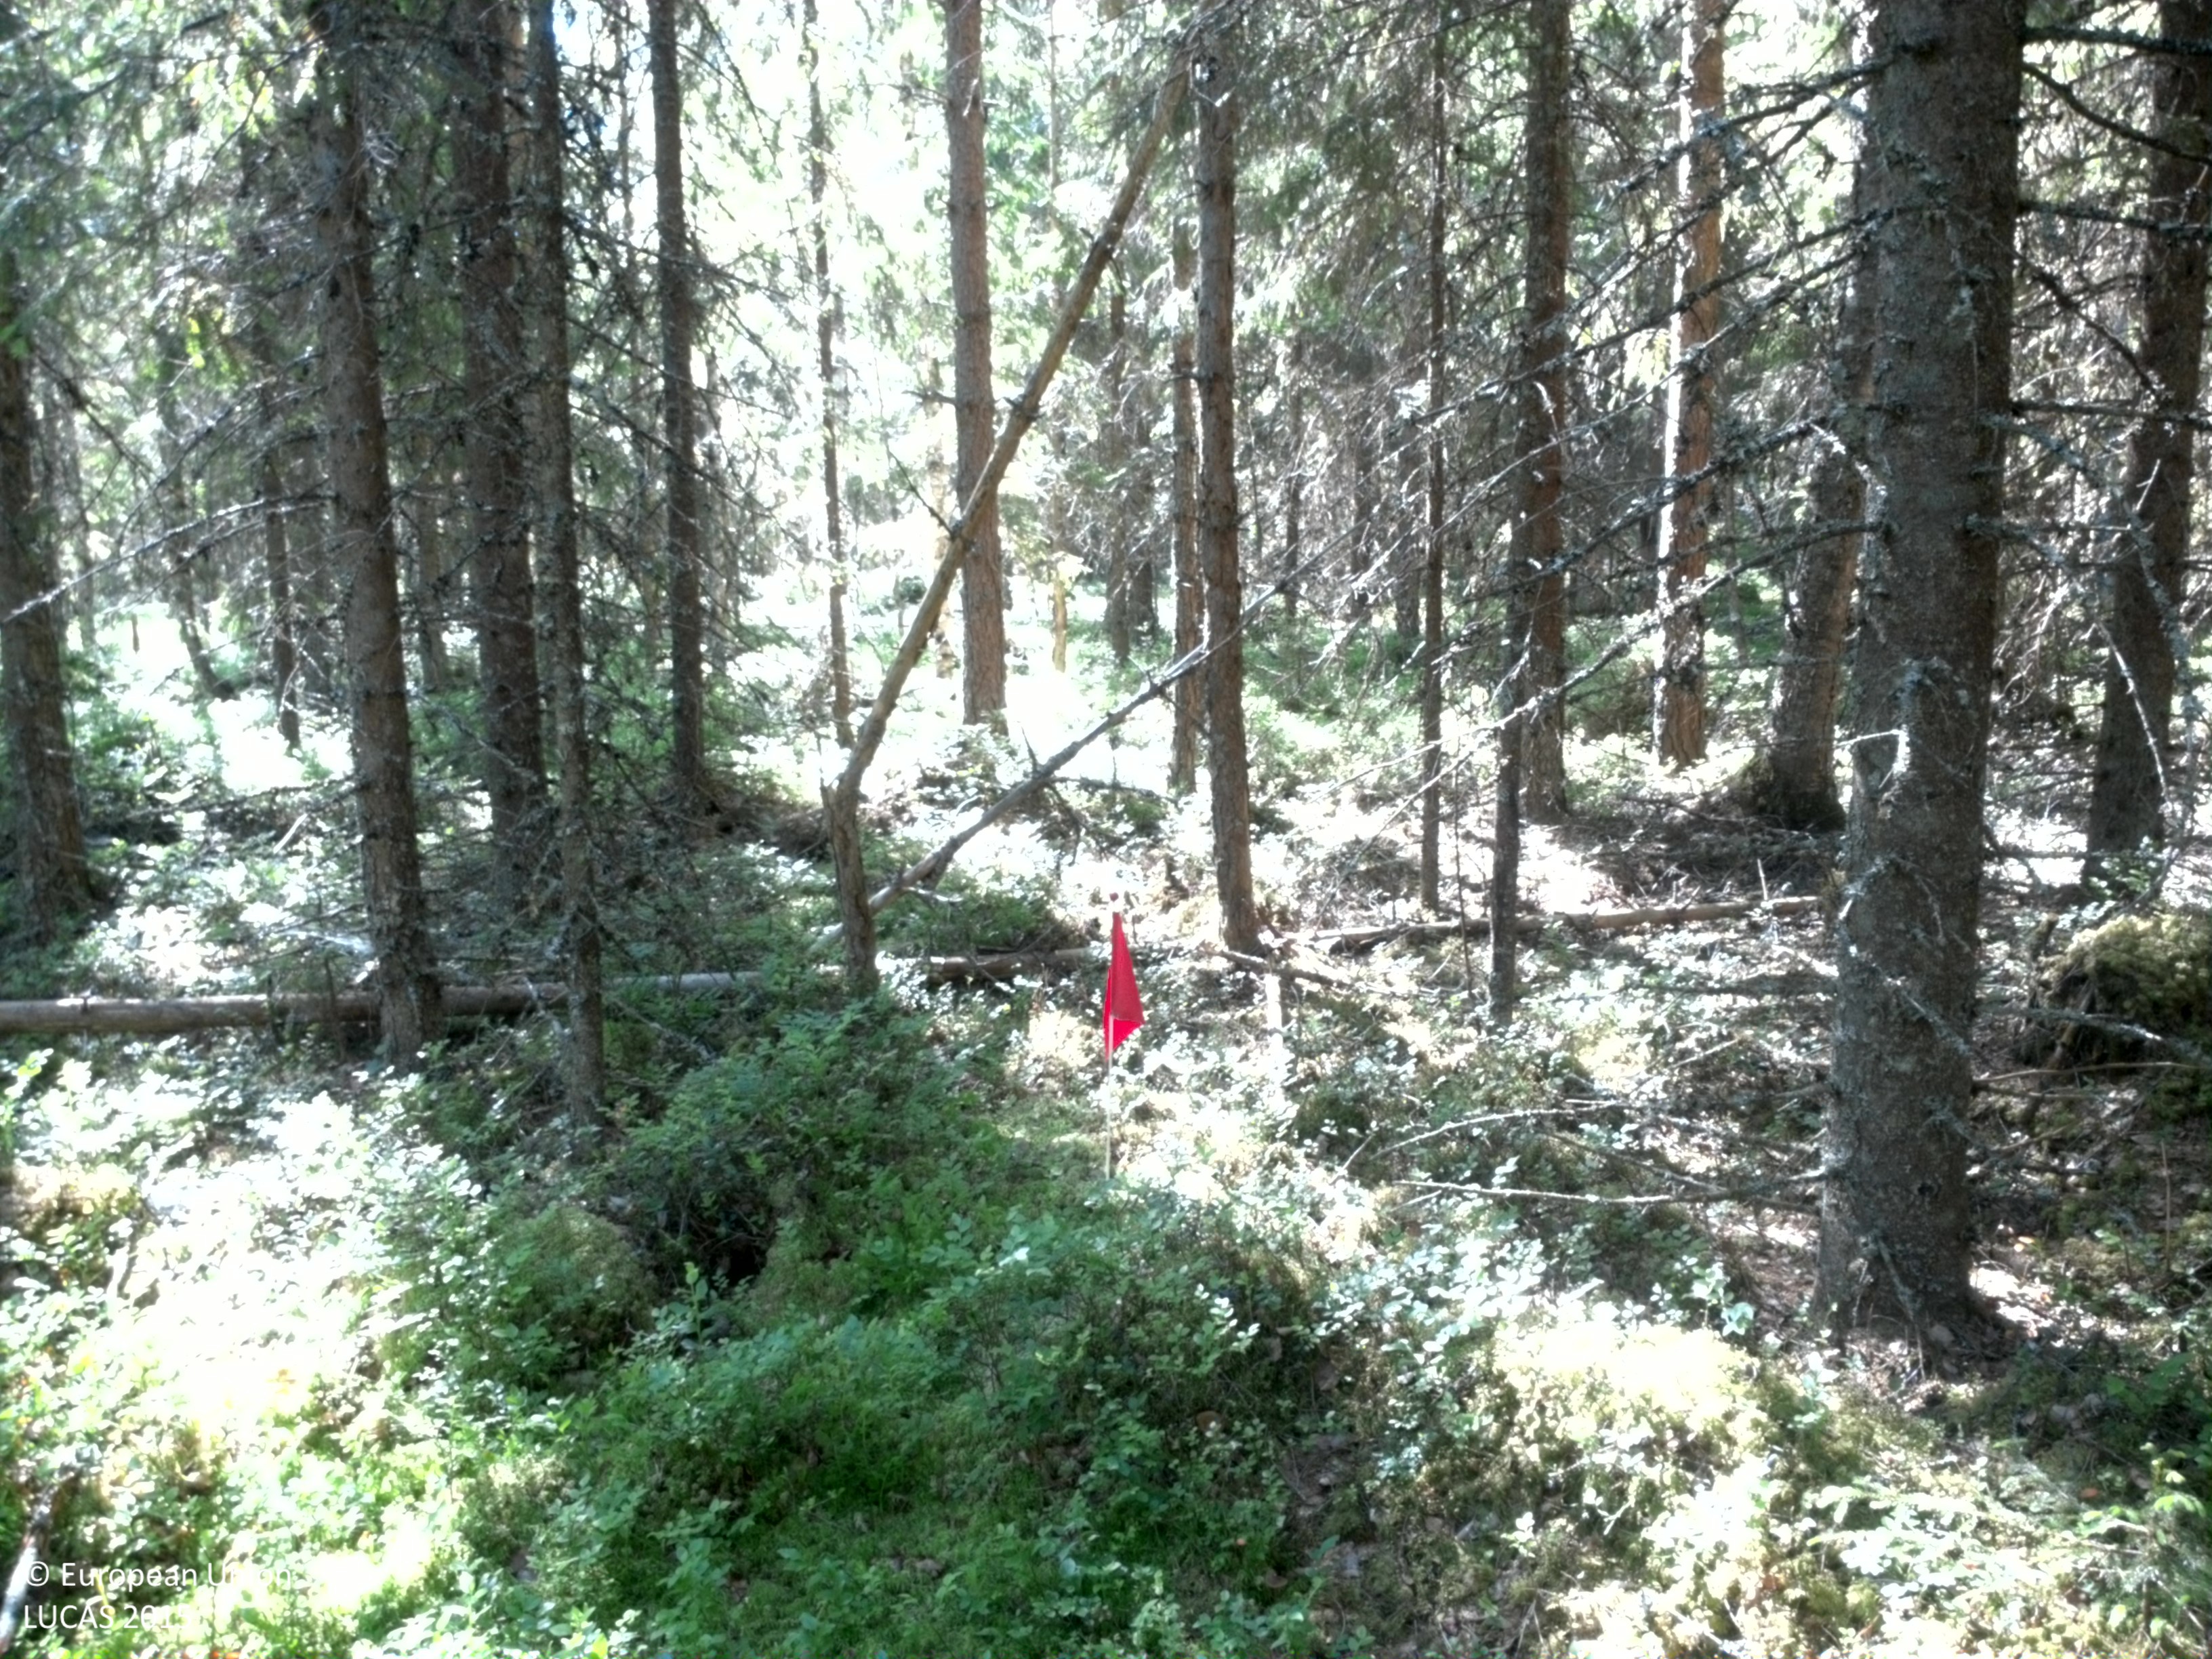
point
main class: Woodland
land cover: Spruce dominated mixed woodland
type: boreal forest
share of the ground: 50 - 75 %
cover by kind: coniferous forest trees 45 %, shrubs 25 %, broadleaved forest trees 15 %, lichens and mosses 15 %
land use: Forestry
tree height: > 5 m
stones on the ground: < 10 %
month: July
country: SE
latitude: 59.7712
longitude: 11.9356
